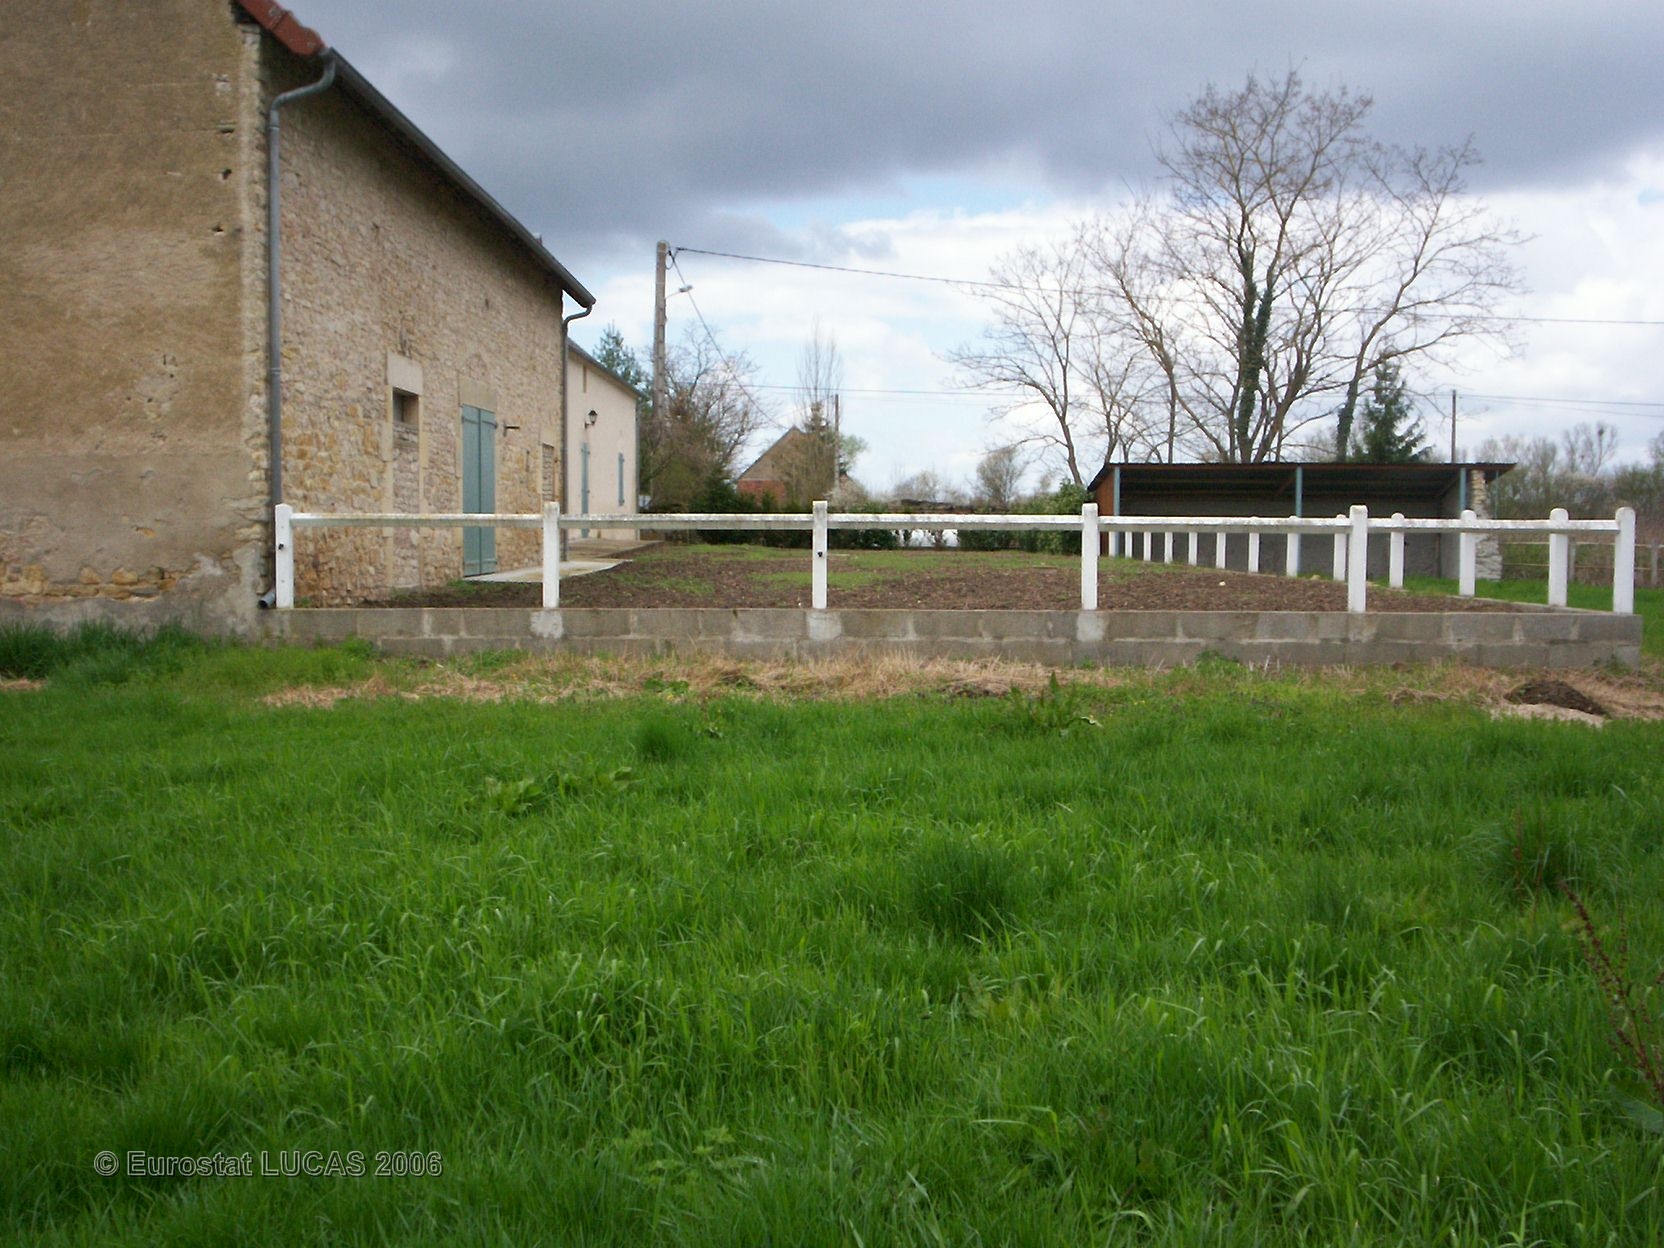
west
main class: Grassland
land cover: Grassland without tree/shrub cover
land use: Agriculture (excluding fallow land and kitchen gardens)
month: April
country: FR
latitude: 46.8502
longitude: 3.0850
